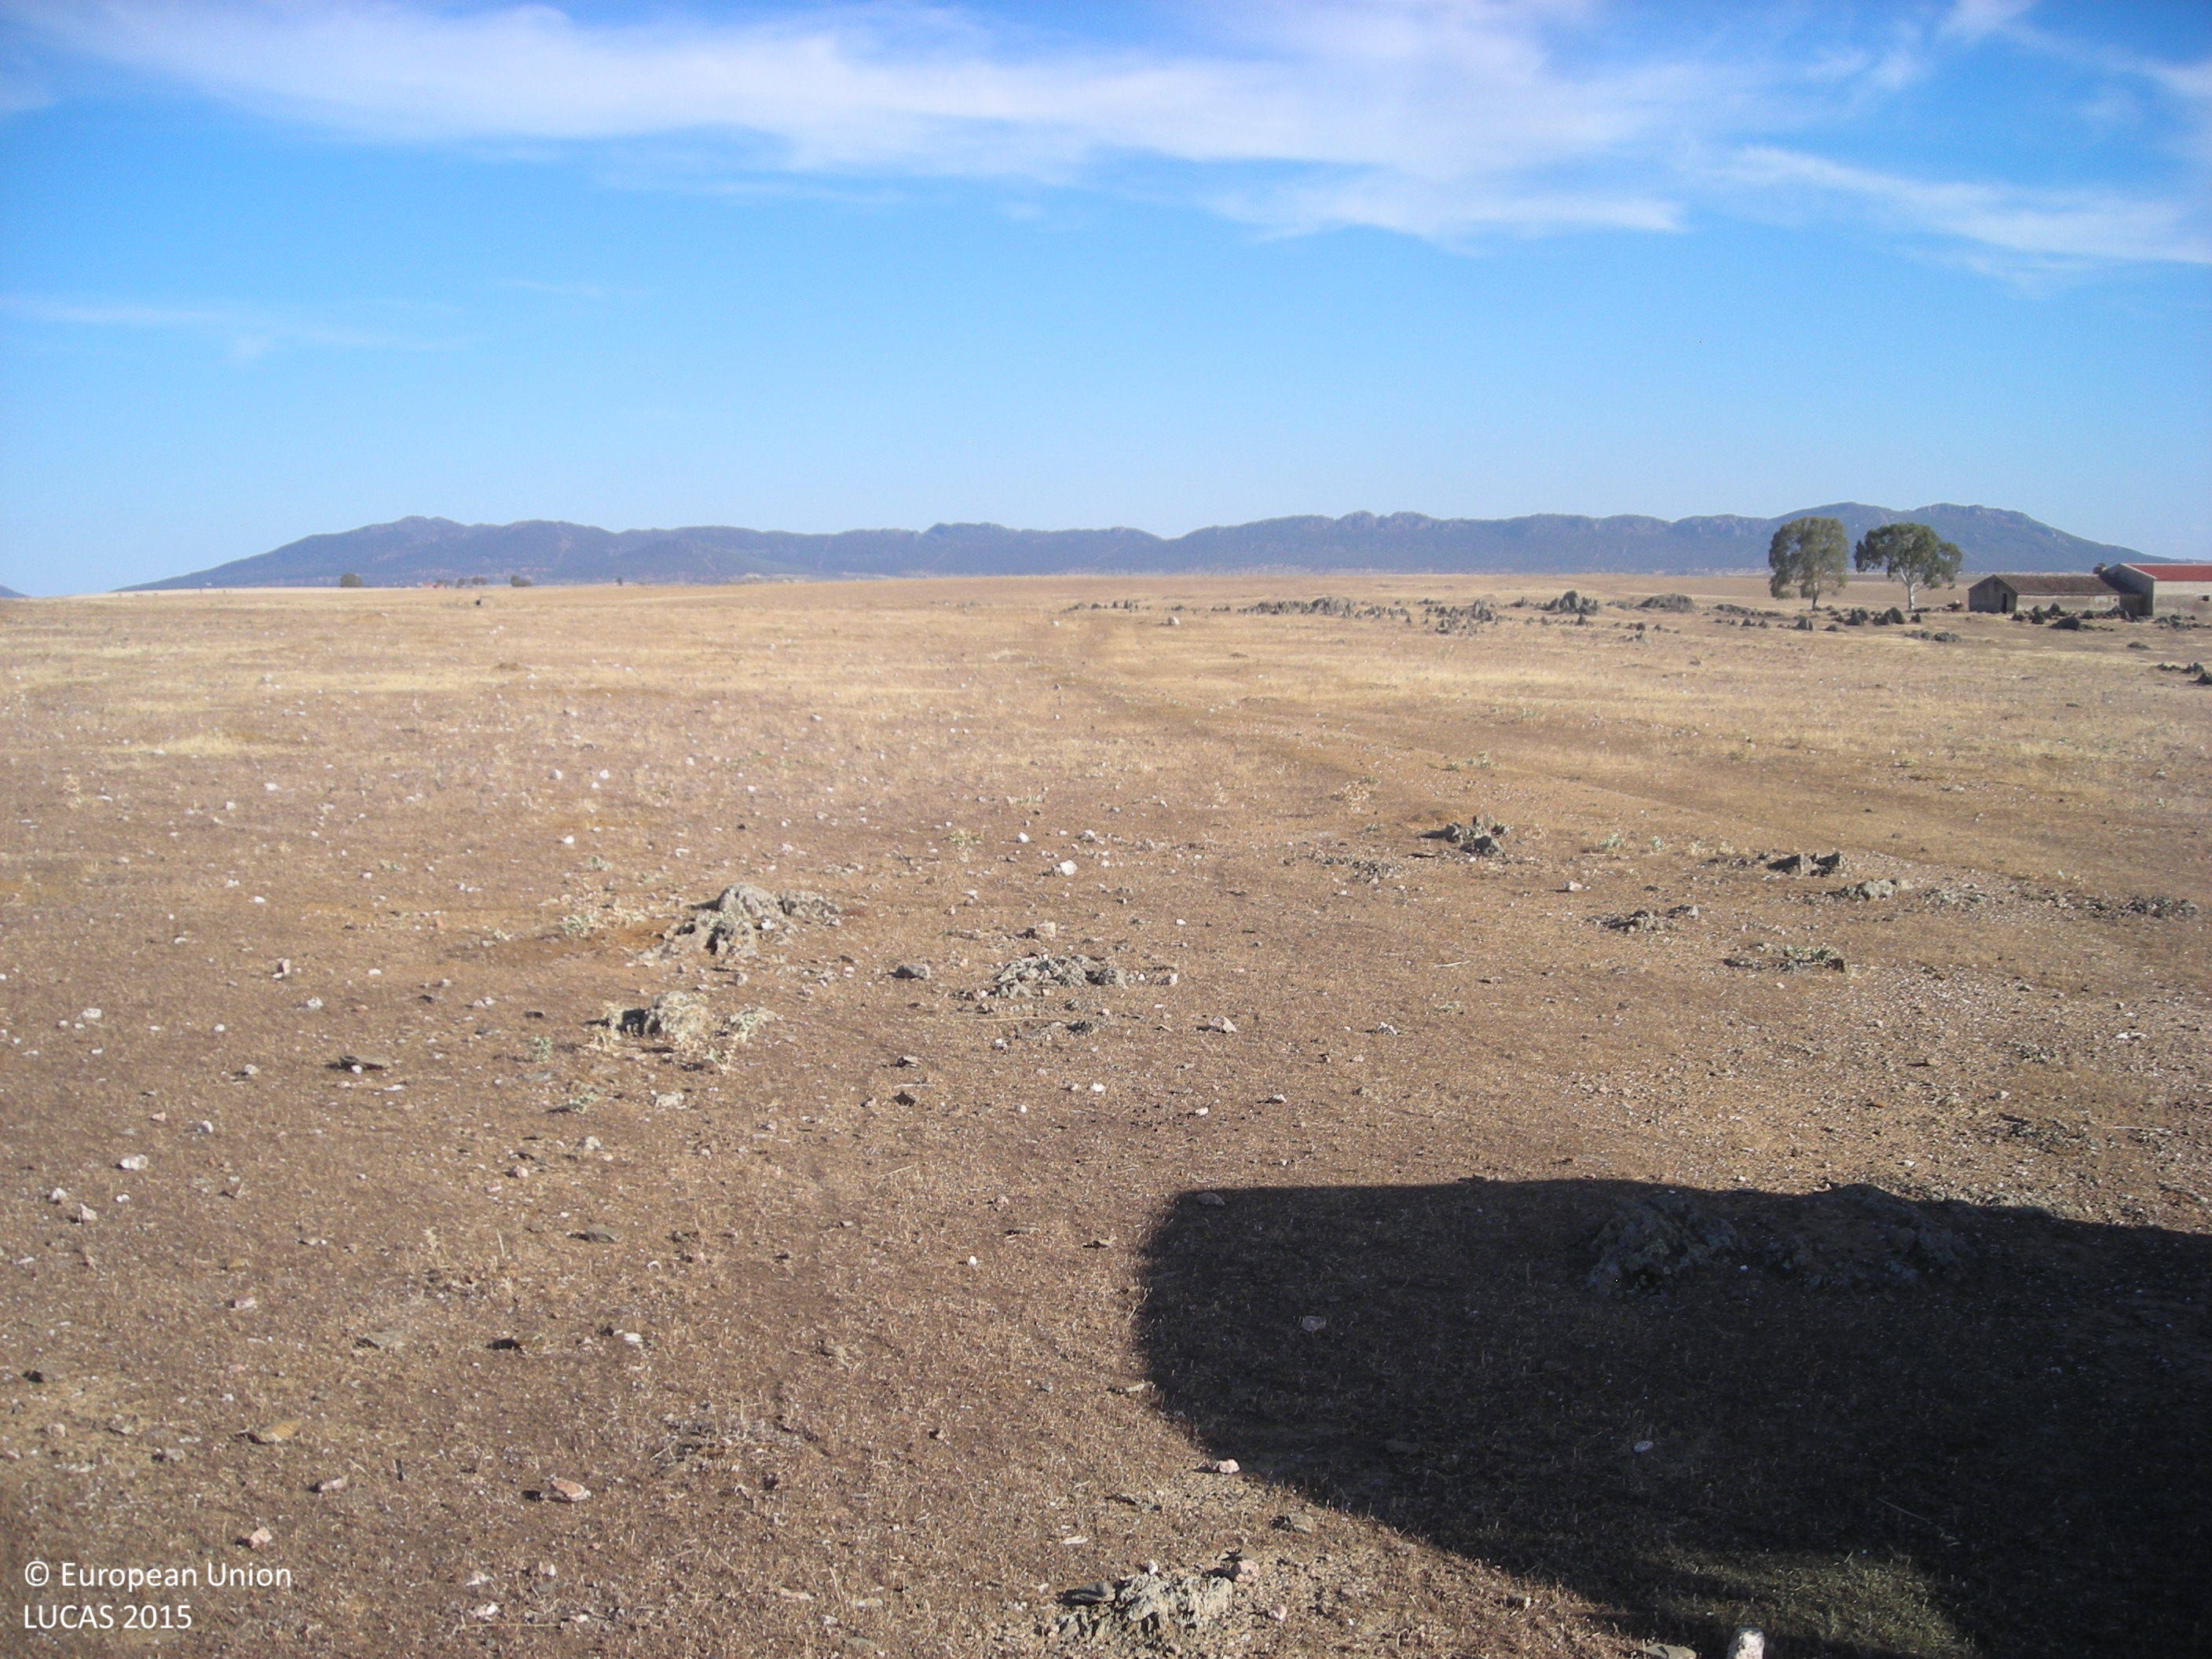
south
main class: Grassland
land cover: Grassland without tree/shrub cover
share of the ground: > 75 %
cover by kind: herbaceous plants 100 %
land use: Agriculture (excluding fallow land and kitchen gardens)
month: July
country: ES
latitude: 38.7988
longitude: -5.4337
